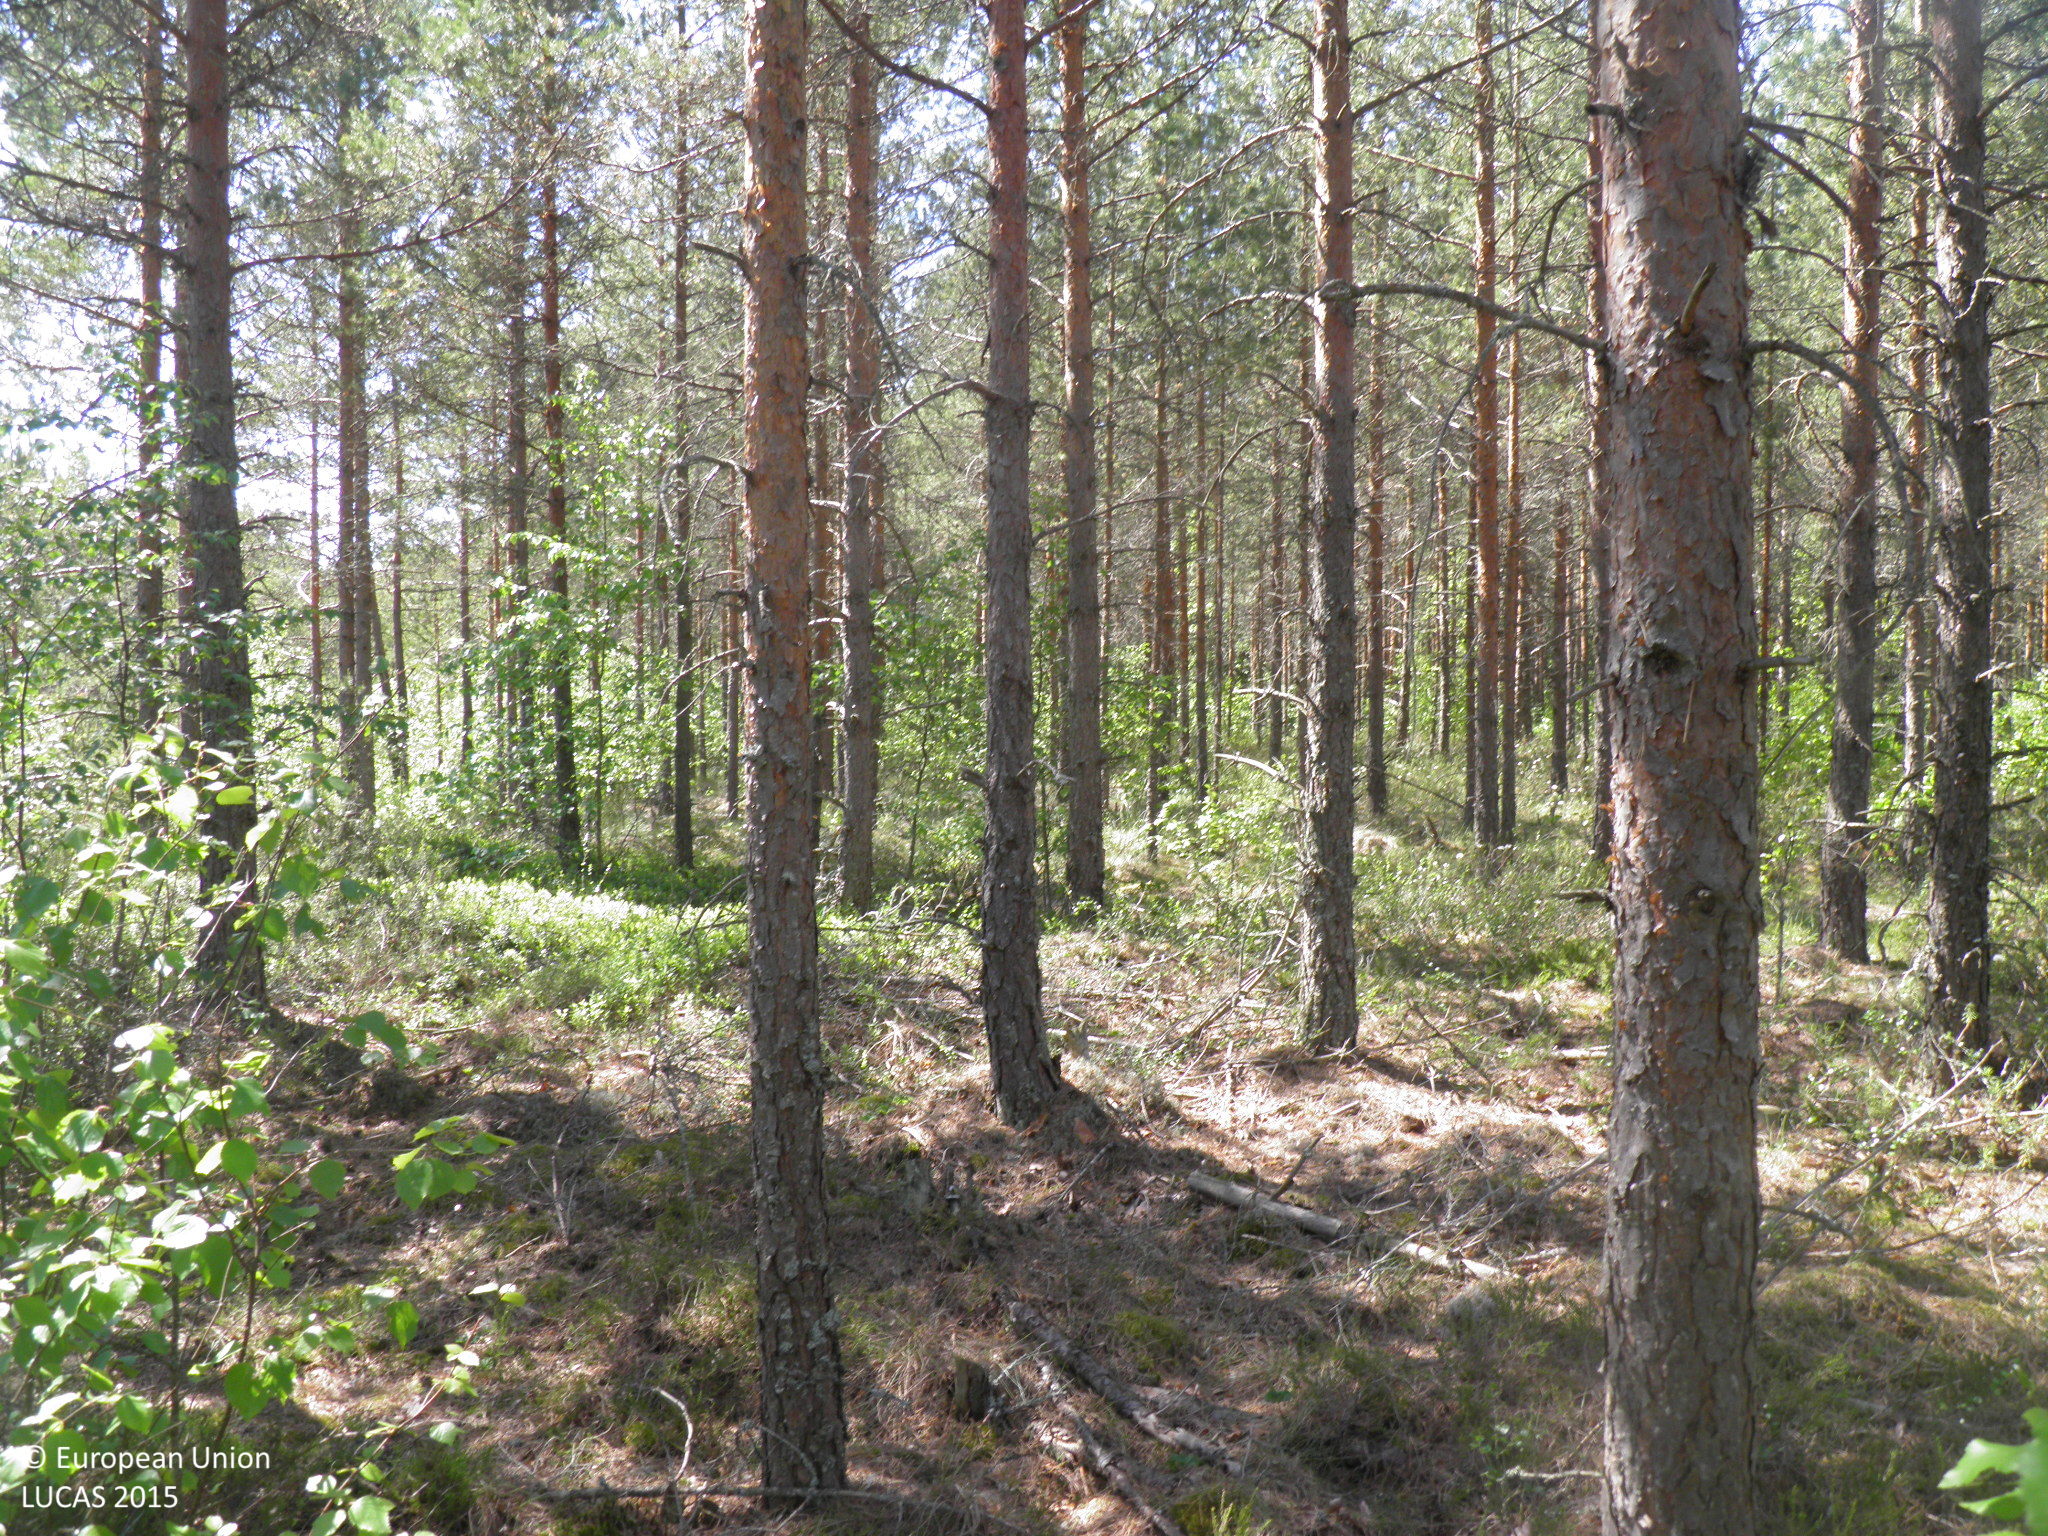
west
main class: Woodland
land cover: Pine dominated coniferous woodland
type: boreal forest
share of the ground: > 75 %
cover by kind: coniferous forest trees 80 %, broadleaved forest trees 5 %, shrubs 5 %, herbaceous plants 5 %, lichens and mosses 5 %
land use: Forestry
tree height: < 5 m
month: June
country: FI
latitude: 60.3875
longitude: 22.7198
